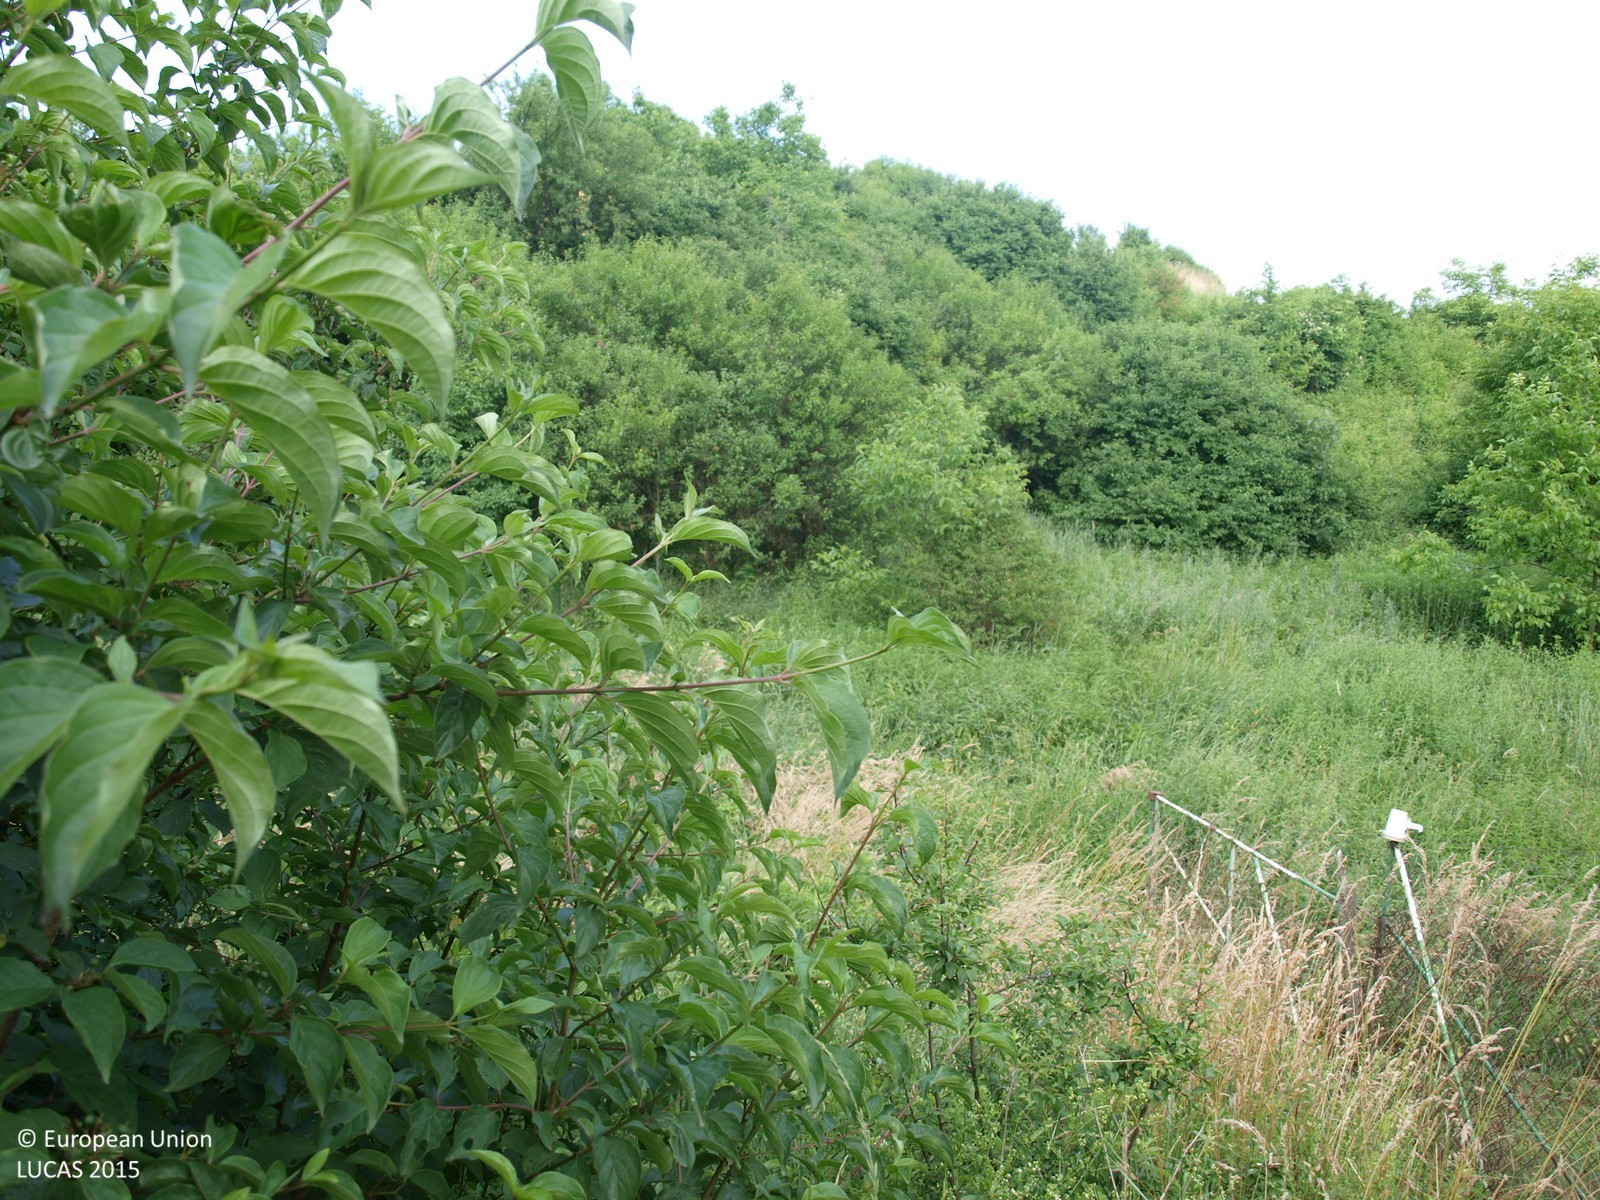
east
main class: Shrubland
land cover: Shrubland with sparse tree cover
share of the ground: > 75 %
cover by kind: shrubs 85 %, herbaceous plants 10 %, broadleaved forest trees 5 %
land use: Abandoned areas
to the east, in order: Shrubland with sparse tree cover; Grassland without tree/shrub cover; Shrubland with sparse tree cover; Maize; Shrubland without tree cover; Barley; Spontaneously vegetated surfaces; Barley; Potatoes; Grassland without tree/shrub cover; Spontaneously vegetated surfaces; Tracks; Grassland without tree/shrub cover
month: June
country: HR
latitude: 46.1815
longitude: 16.3347
